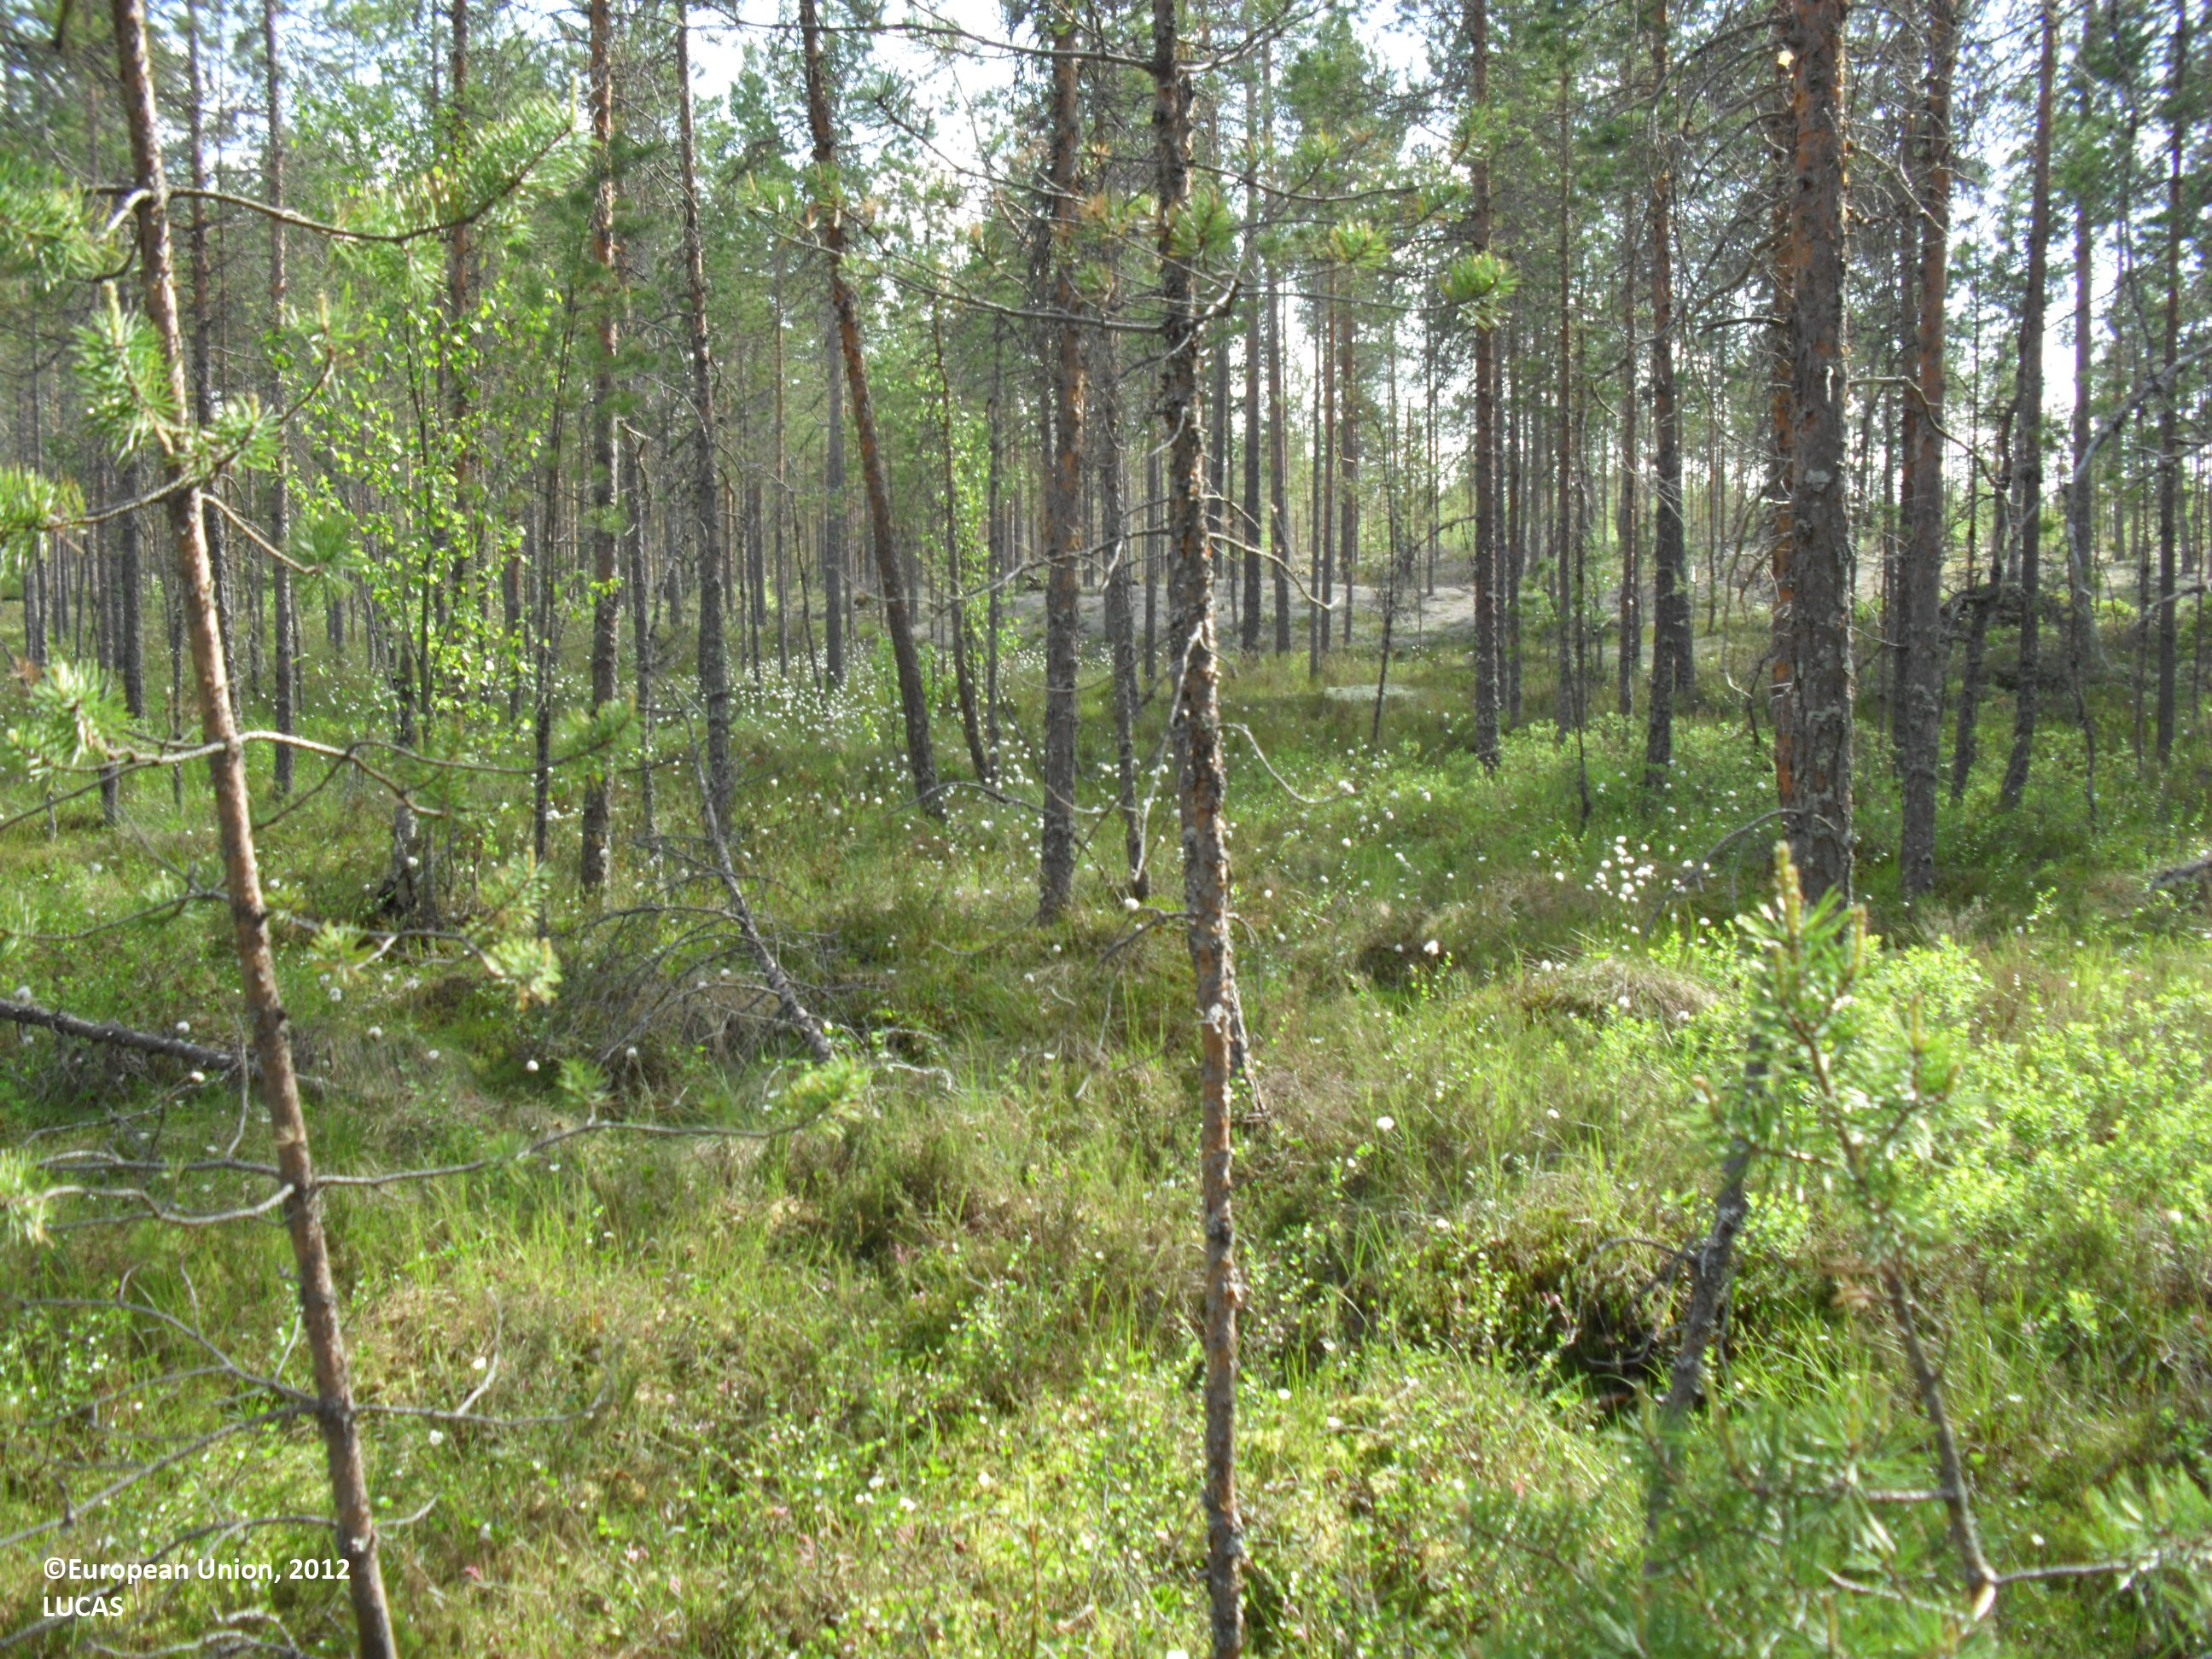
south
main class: Woodland
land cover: Pine dominated coniferous woodland
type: mire and swamp forests
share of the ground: 25 - 50 %
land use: Forestry
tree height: > 5 m
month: June
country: FI
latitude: 62.9237
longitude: 23.4374
